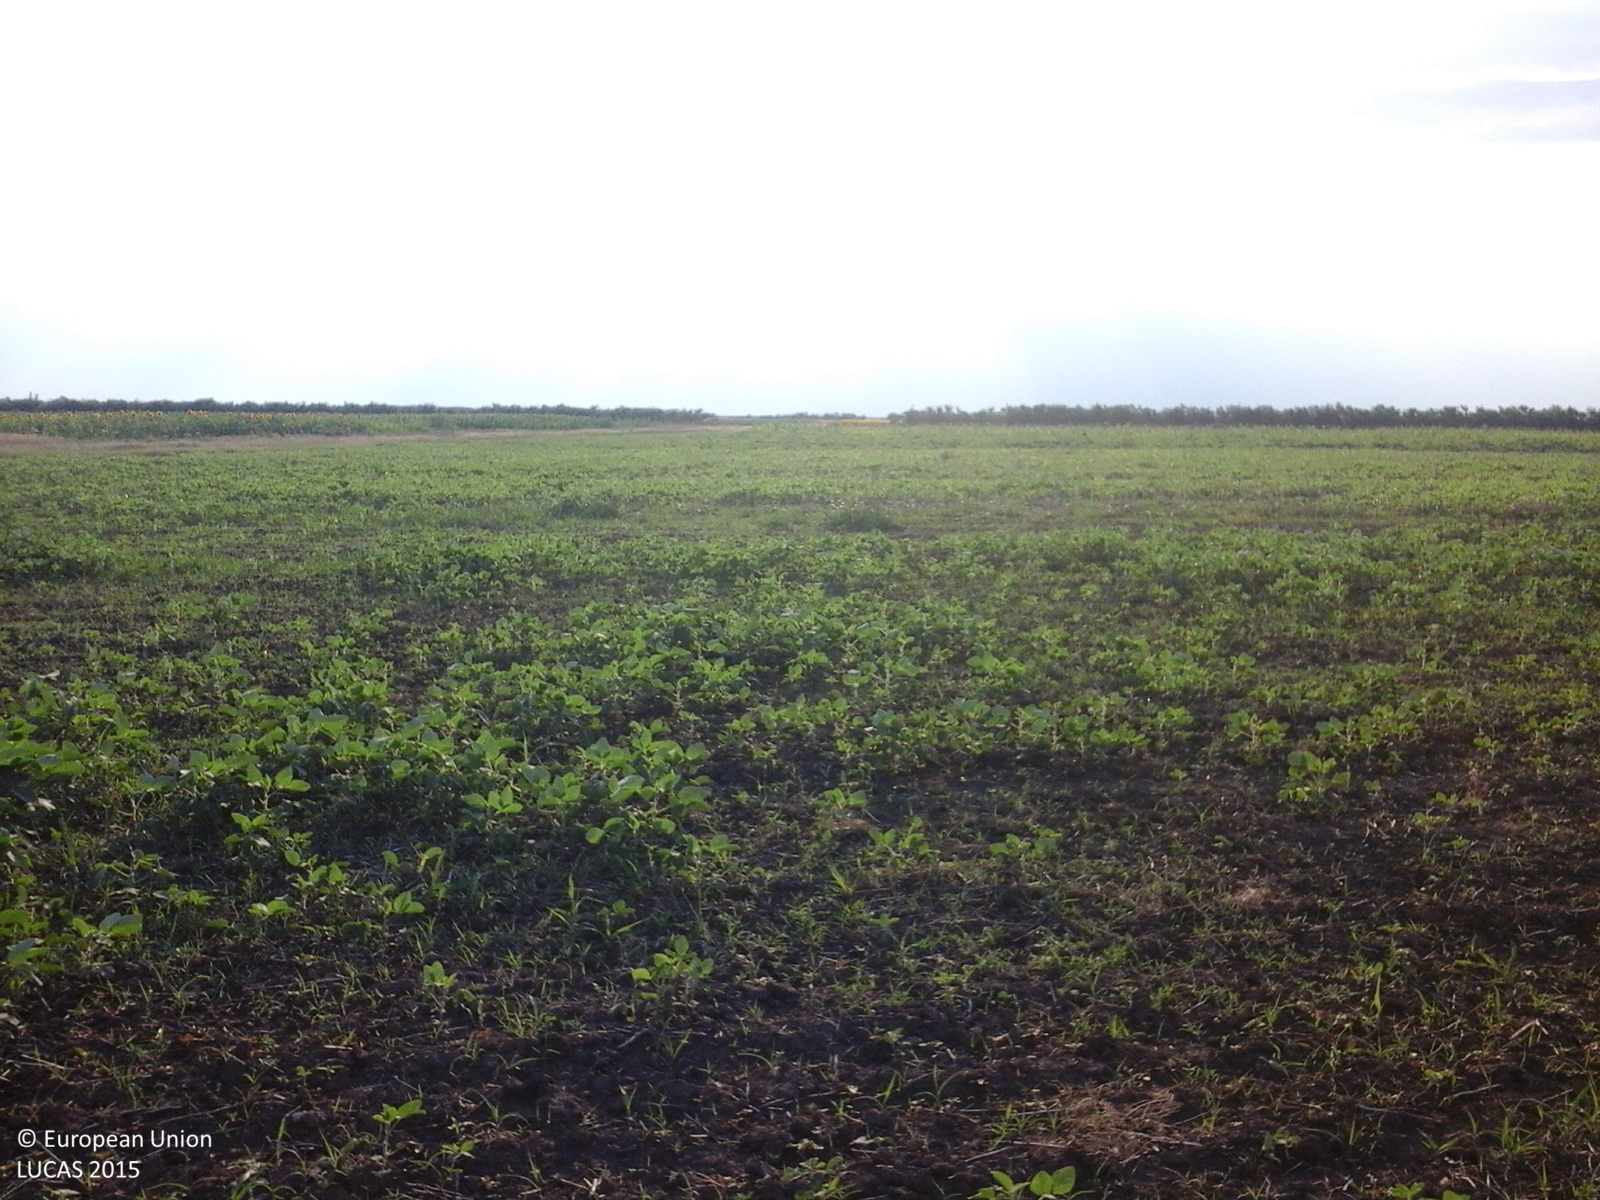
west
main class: Cropland
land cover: Soya
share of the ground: 25 - 50 %
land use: Agriculture (excluding fallow land and kitchen gardens)
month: July
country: RO
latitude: 43.8652
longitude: 24.3086
